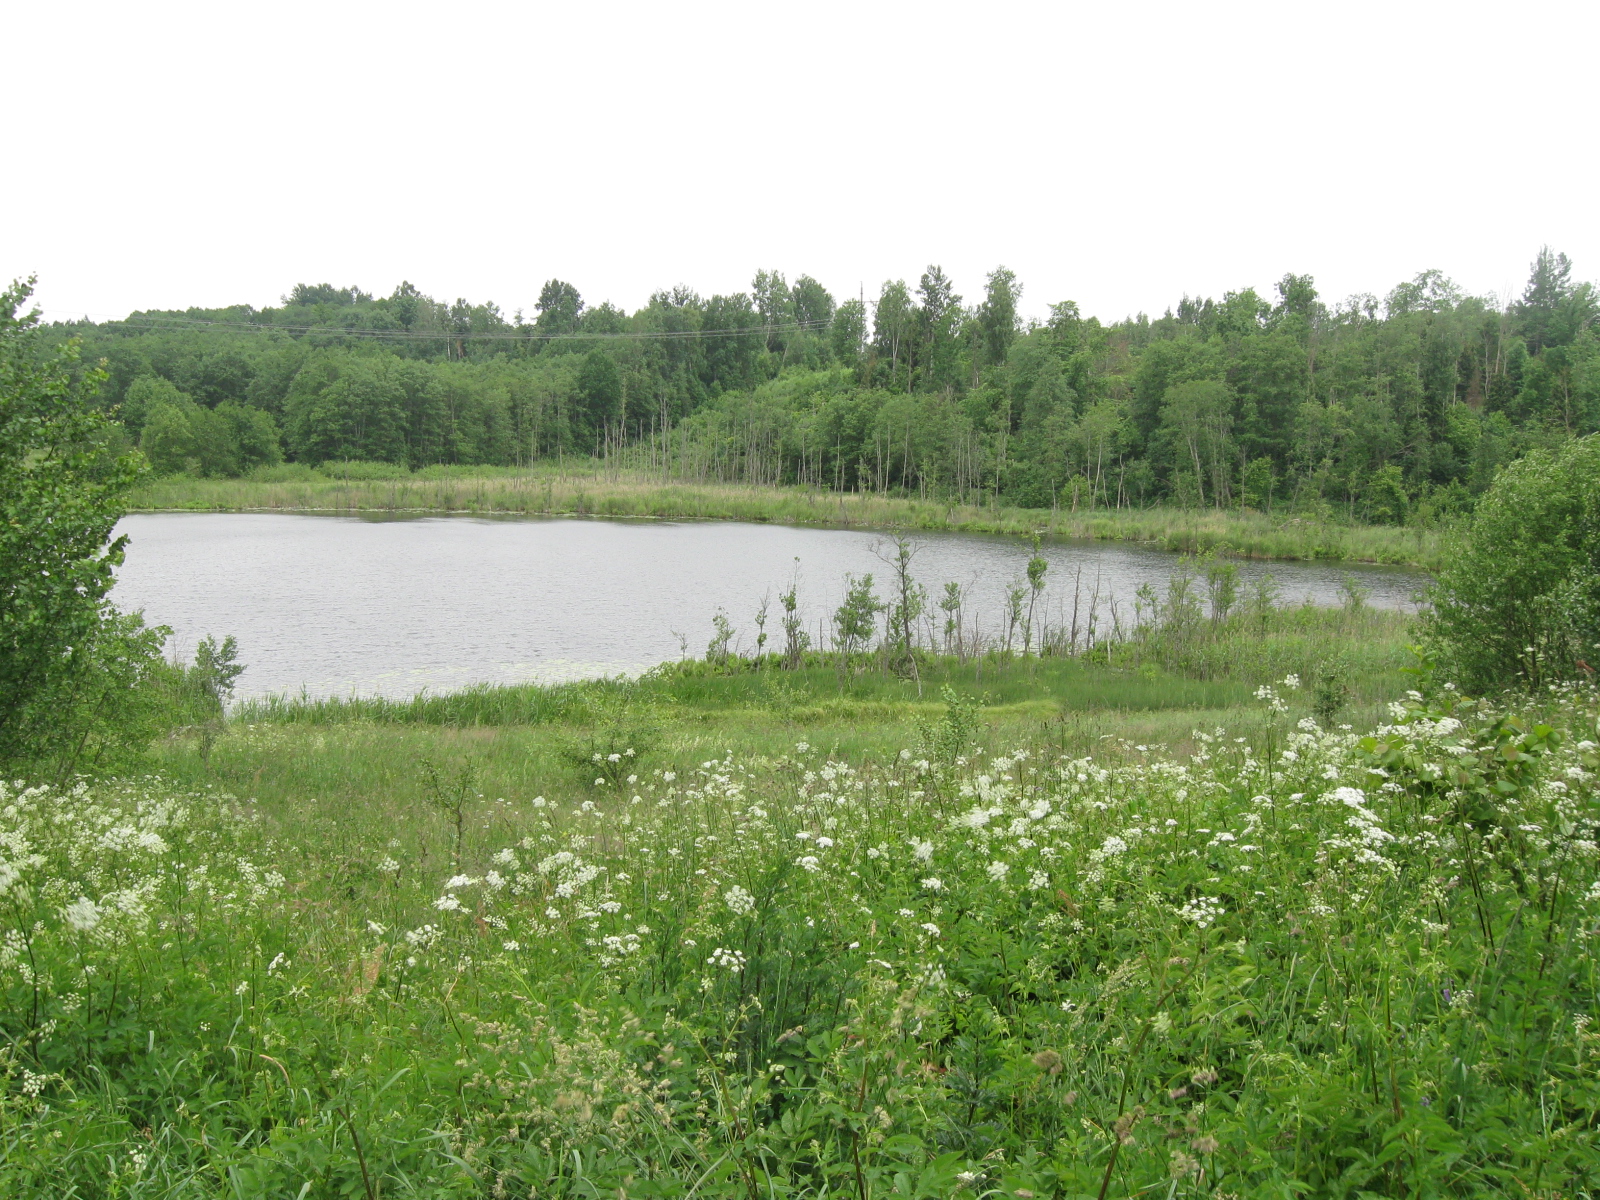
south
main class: Grassland
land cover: Grassland with sparse tree/shrub cover
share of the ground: > 75 %
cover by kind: herbaceous plants 90 %, broadleaved forest trees 5 %, shrubs 5 %
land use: Agriculture (excluding fallow land and kitchen gardens)
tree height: < 5 m
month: June
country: LT
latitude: 54.6236
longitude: 24.3643
